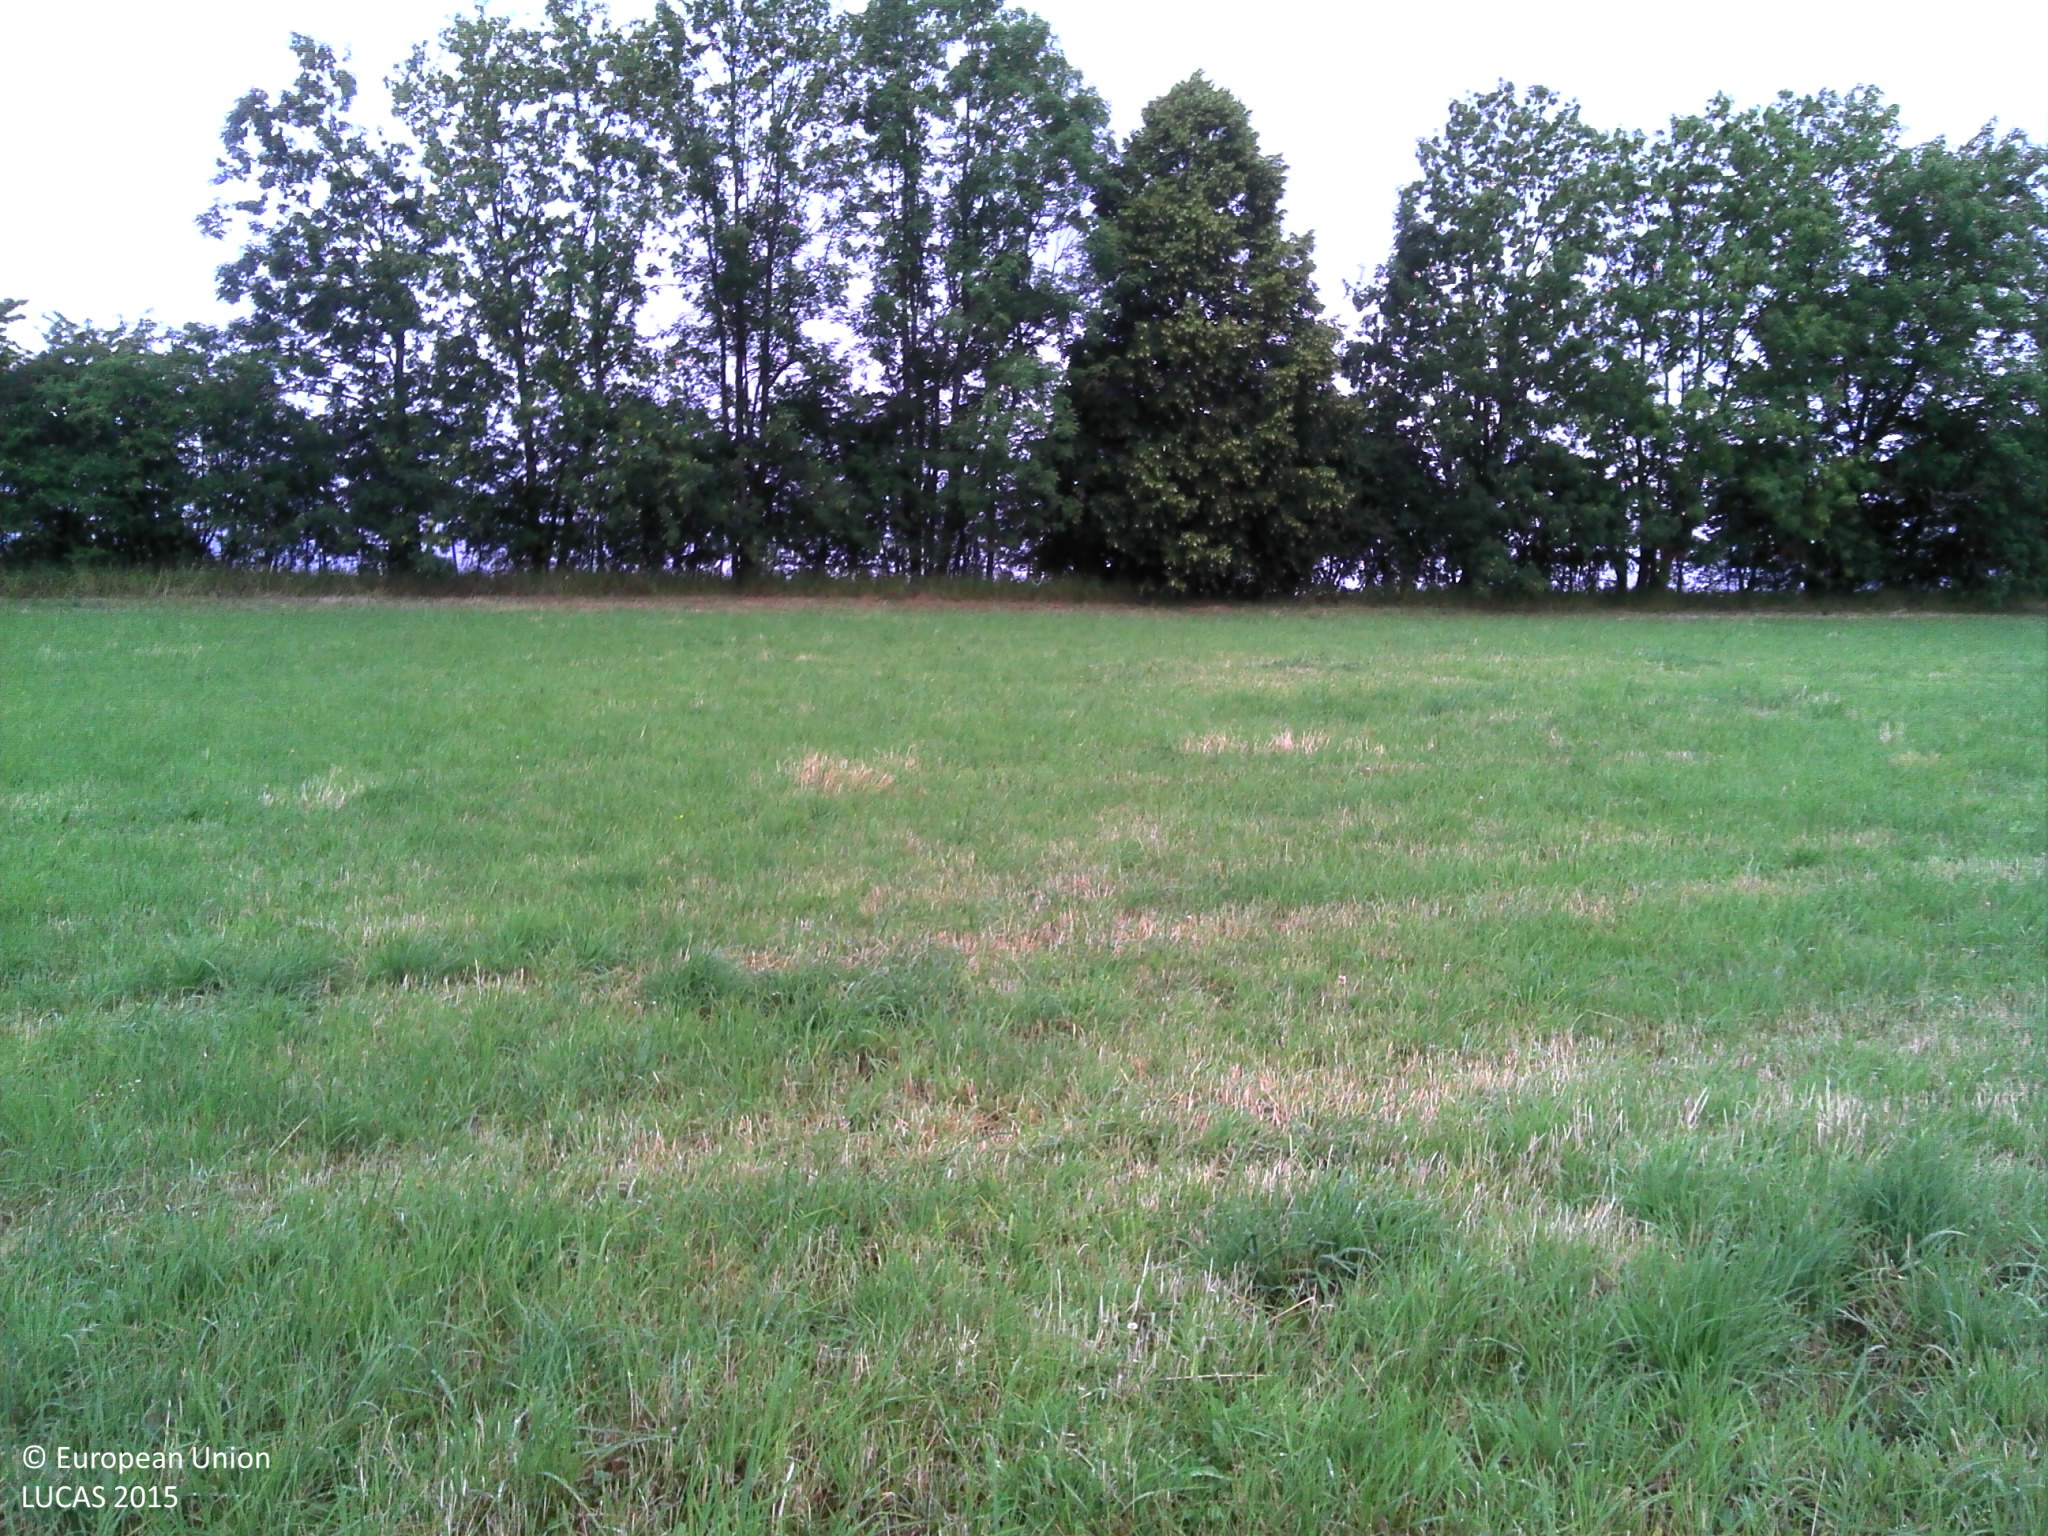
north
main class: Grassland
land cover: Grassland without tree/shrub cover
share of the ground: > 75 %
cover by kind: herbaceous plants 100 %
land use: Agriculture (excluding fallow land and kitchen gardens)
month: July
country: BE
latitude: 50.1065
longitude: 5.7902
